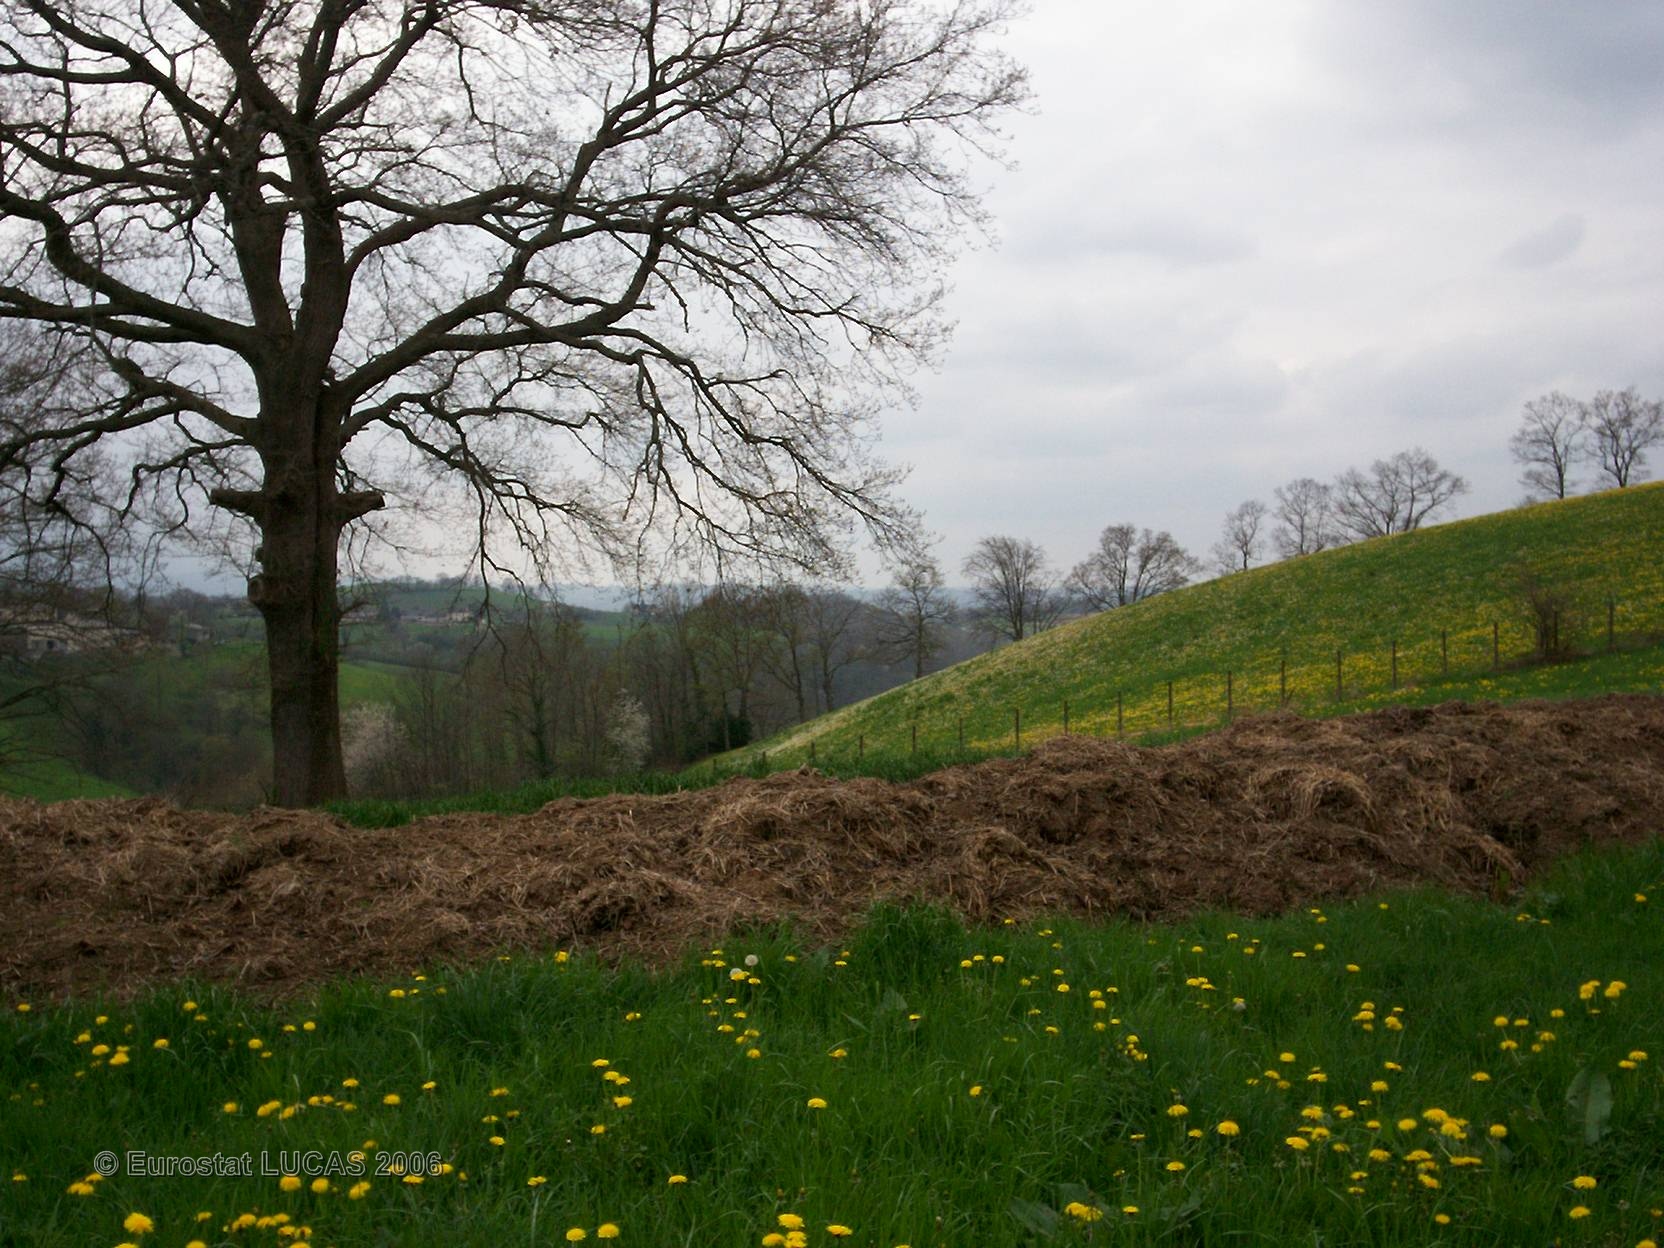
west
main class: Grassland
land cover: Grassland without tree/shrub cover
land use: Agriculture (excluding fallow land and kitchen gardens)
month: April
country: FR
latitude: 43.1180
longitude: -0.2175
